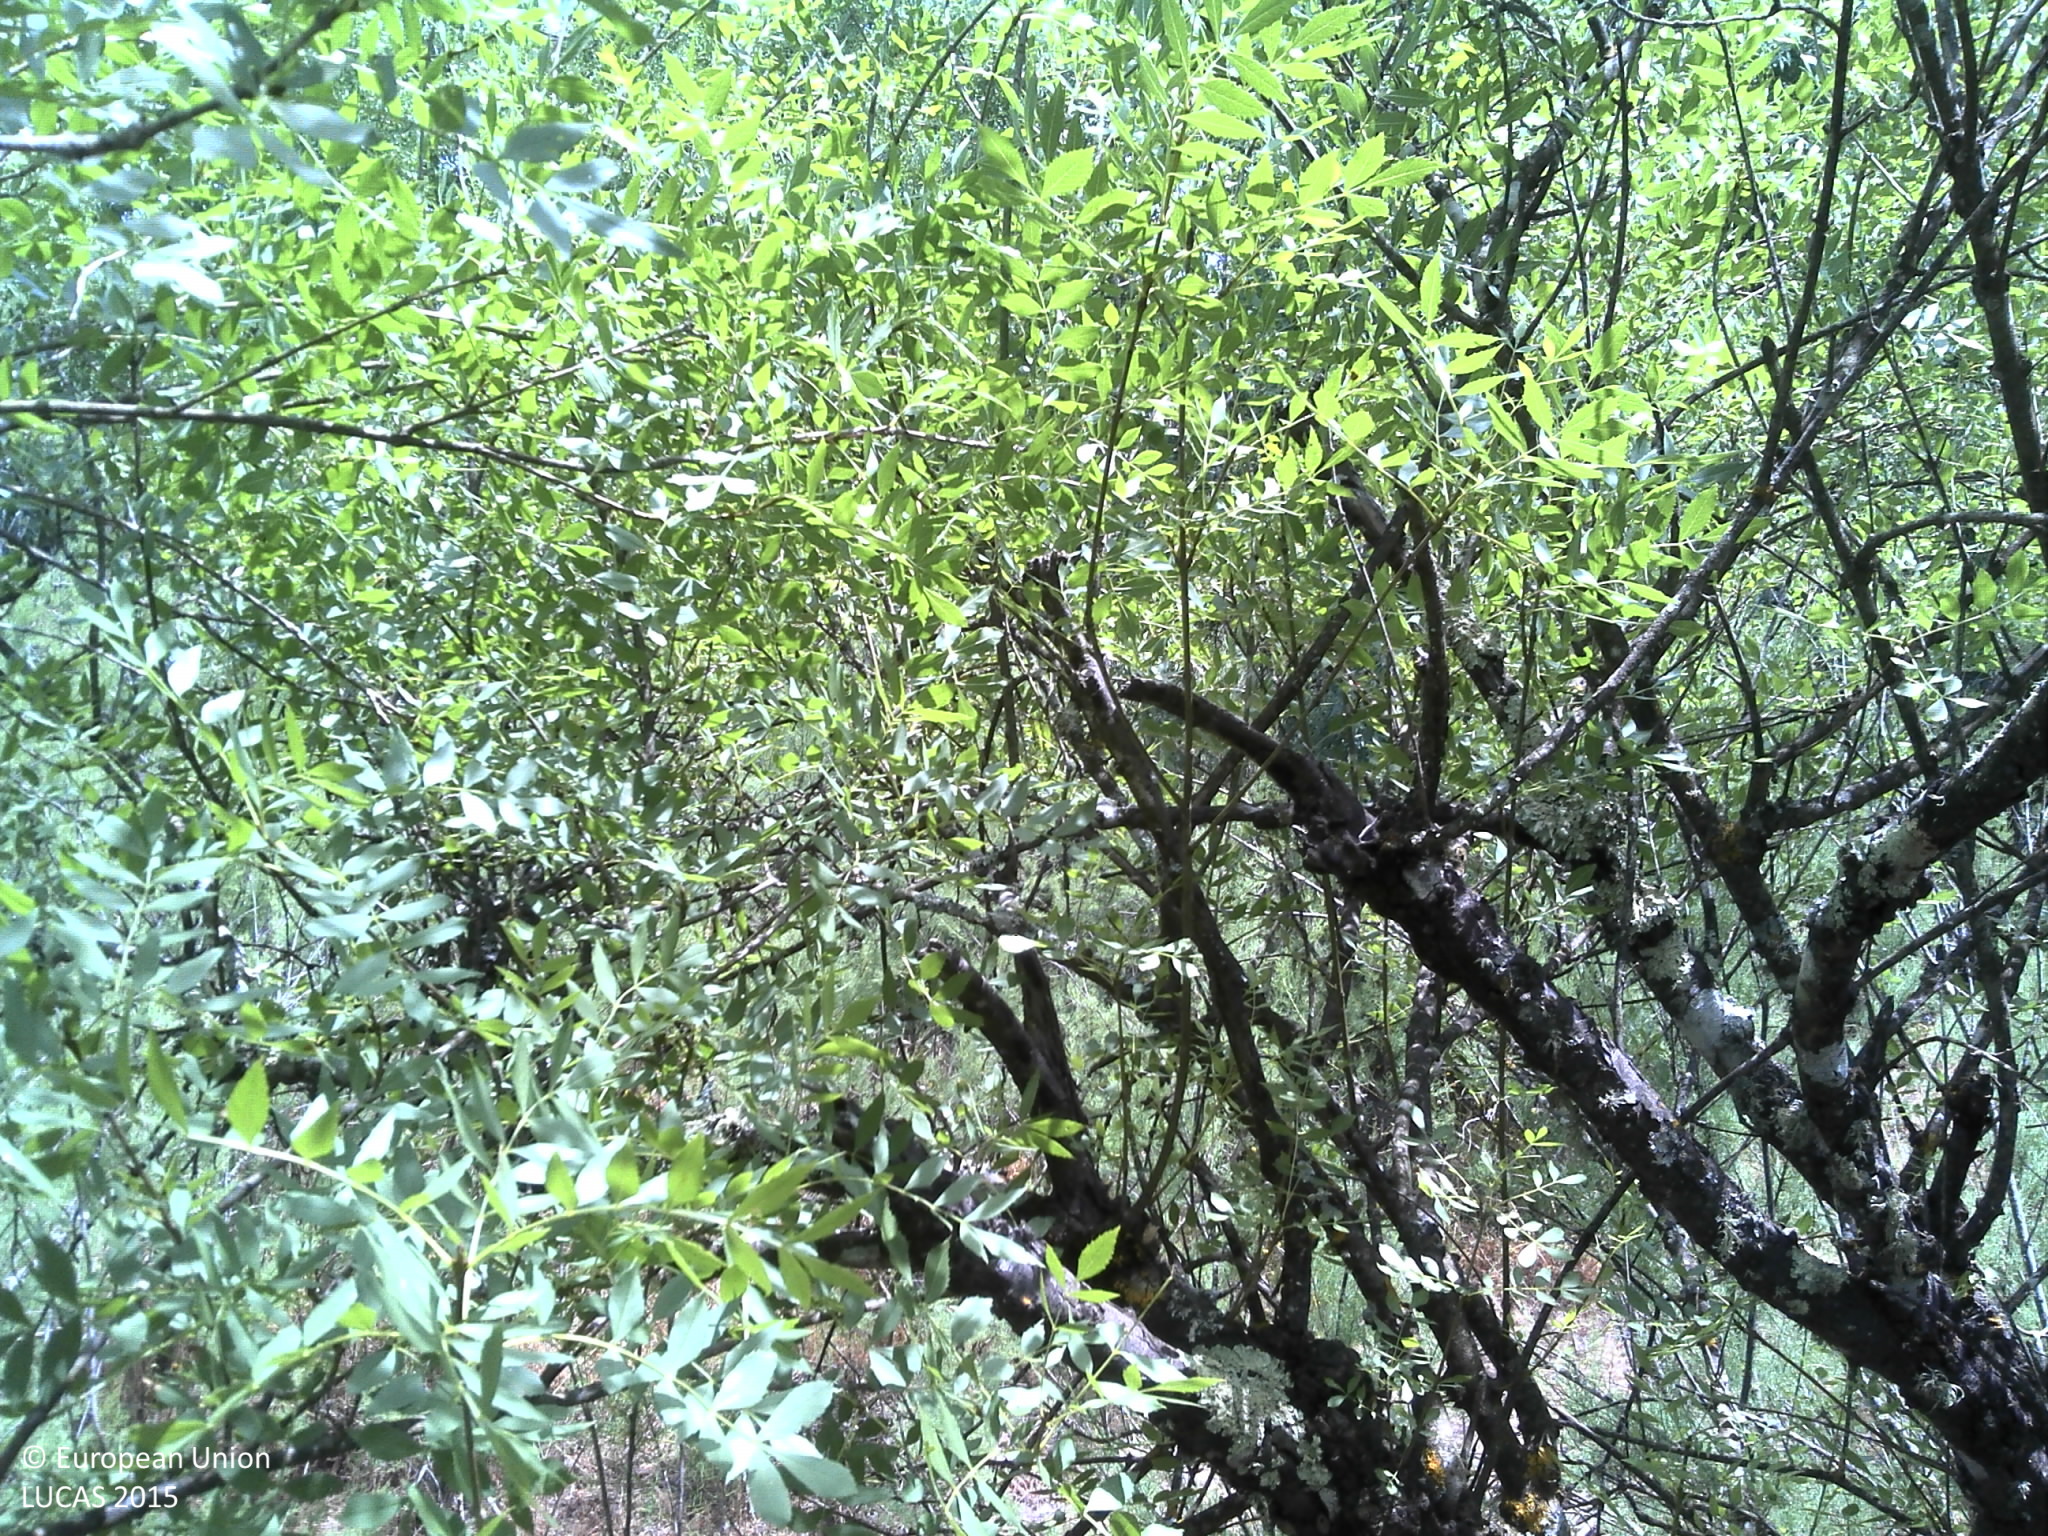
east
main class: Woodland
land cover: Broadleaved woodland
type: floodplain forest
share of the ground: 50 - 75 %
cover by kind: broadleaved forest trees 50 %, shrubs 25 %, unconsolidated bare surface 15 %, herbaceous plants 10 %
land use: Semi-natural and natural areas not in use
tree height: > 5 m
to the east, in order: Broadleaved woodland; Inland fresh running water; Broadleaved woodland; Pine dominated coniferous woodland; Broadleaved woodland
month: May
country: PT
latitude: 38.0342
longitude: -8.3722
